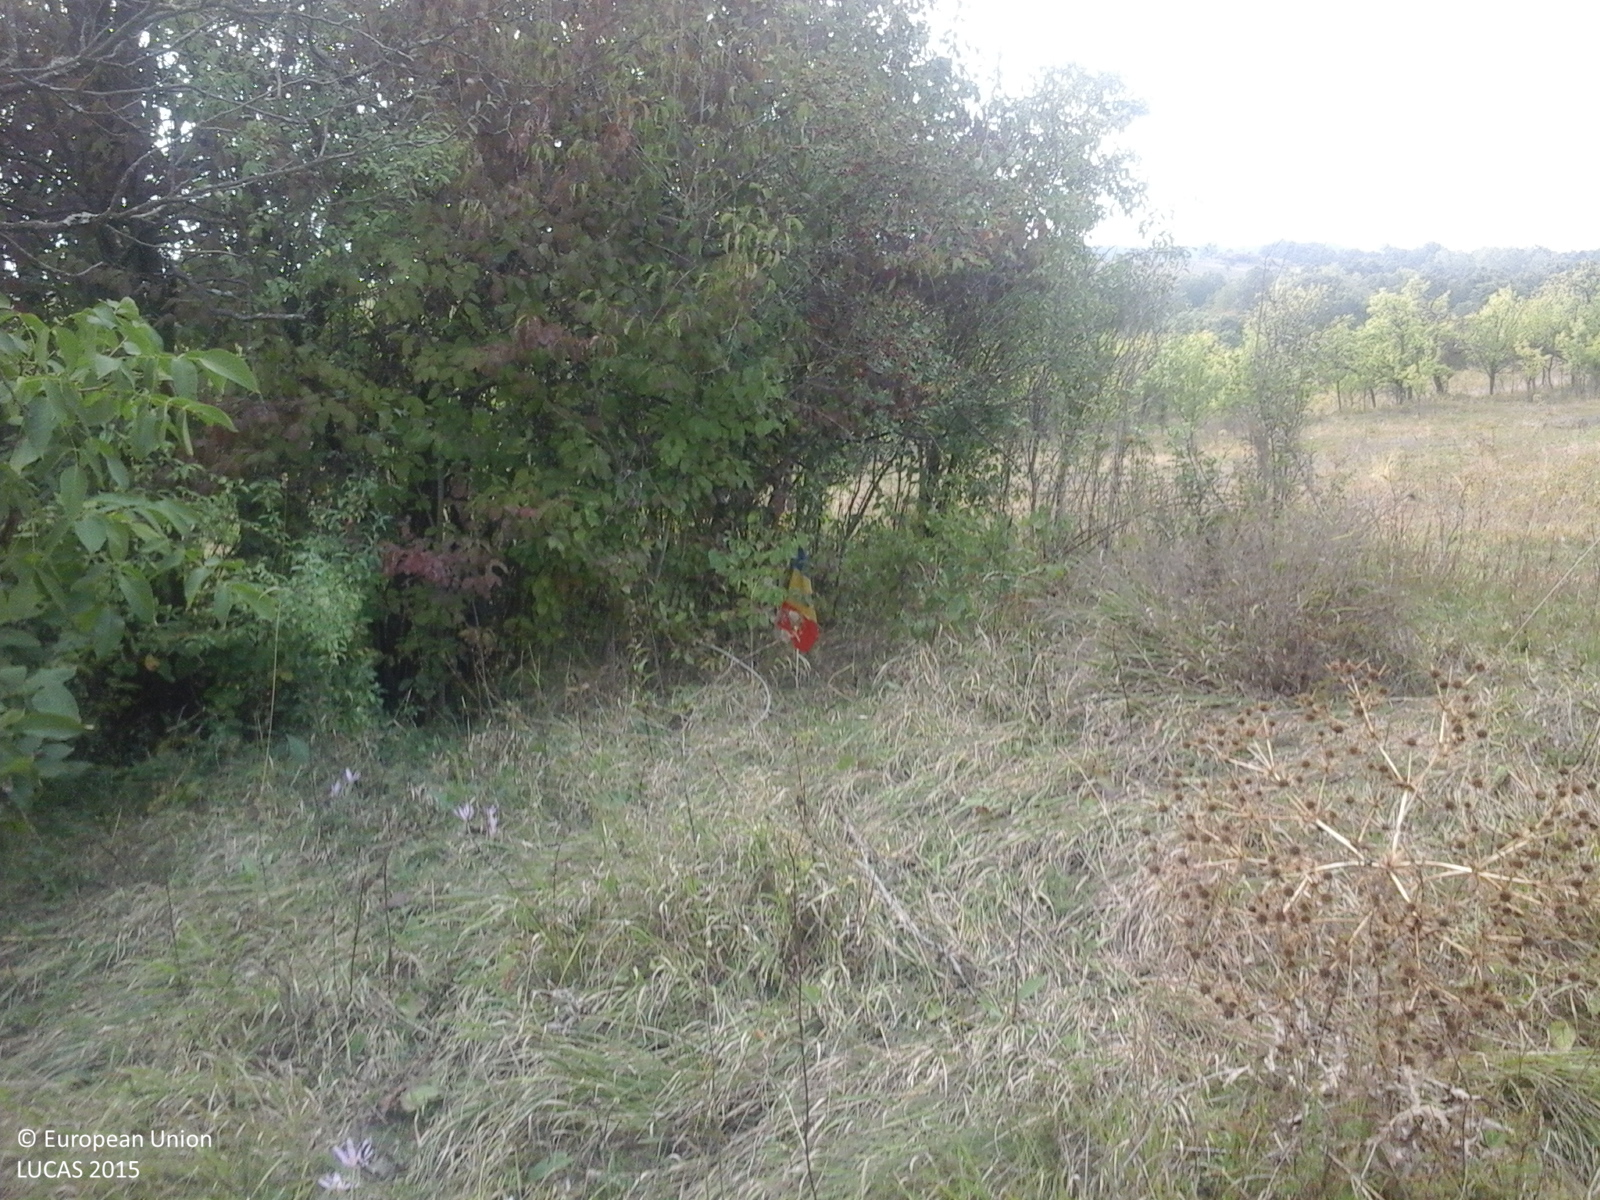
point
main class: Shrubland
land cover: Shrubland with sparse tree cover
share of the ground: > 75 %
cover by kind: shrubs 75 %, herbaceous plants 20 %, broadleaved forest trees 5 %
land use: Fallow land
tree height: > 5 m
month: September
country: RO
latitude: 45.8086
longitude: 22.8565
